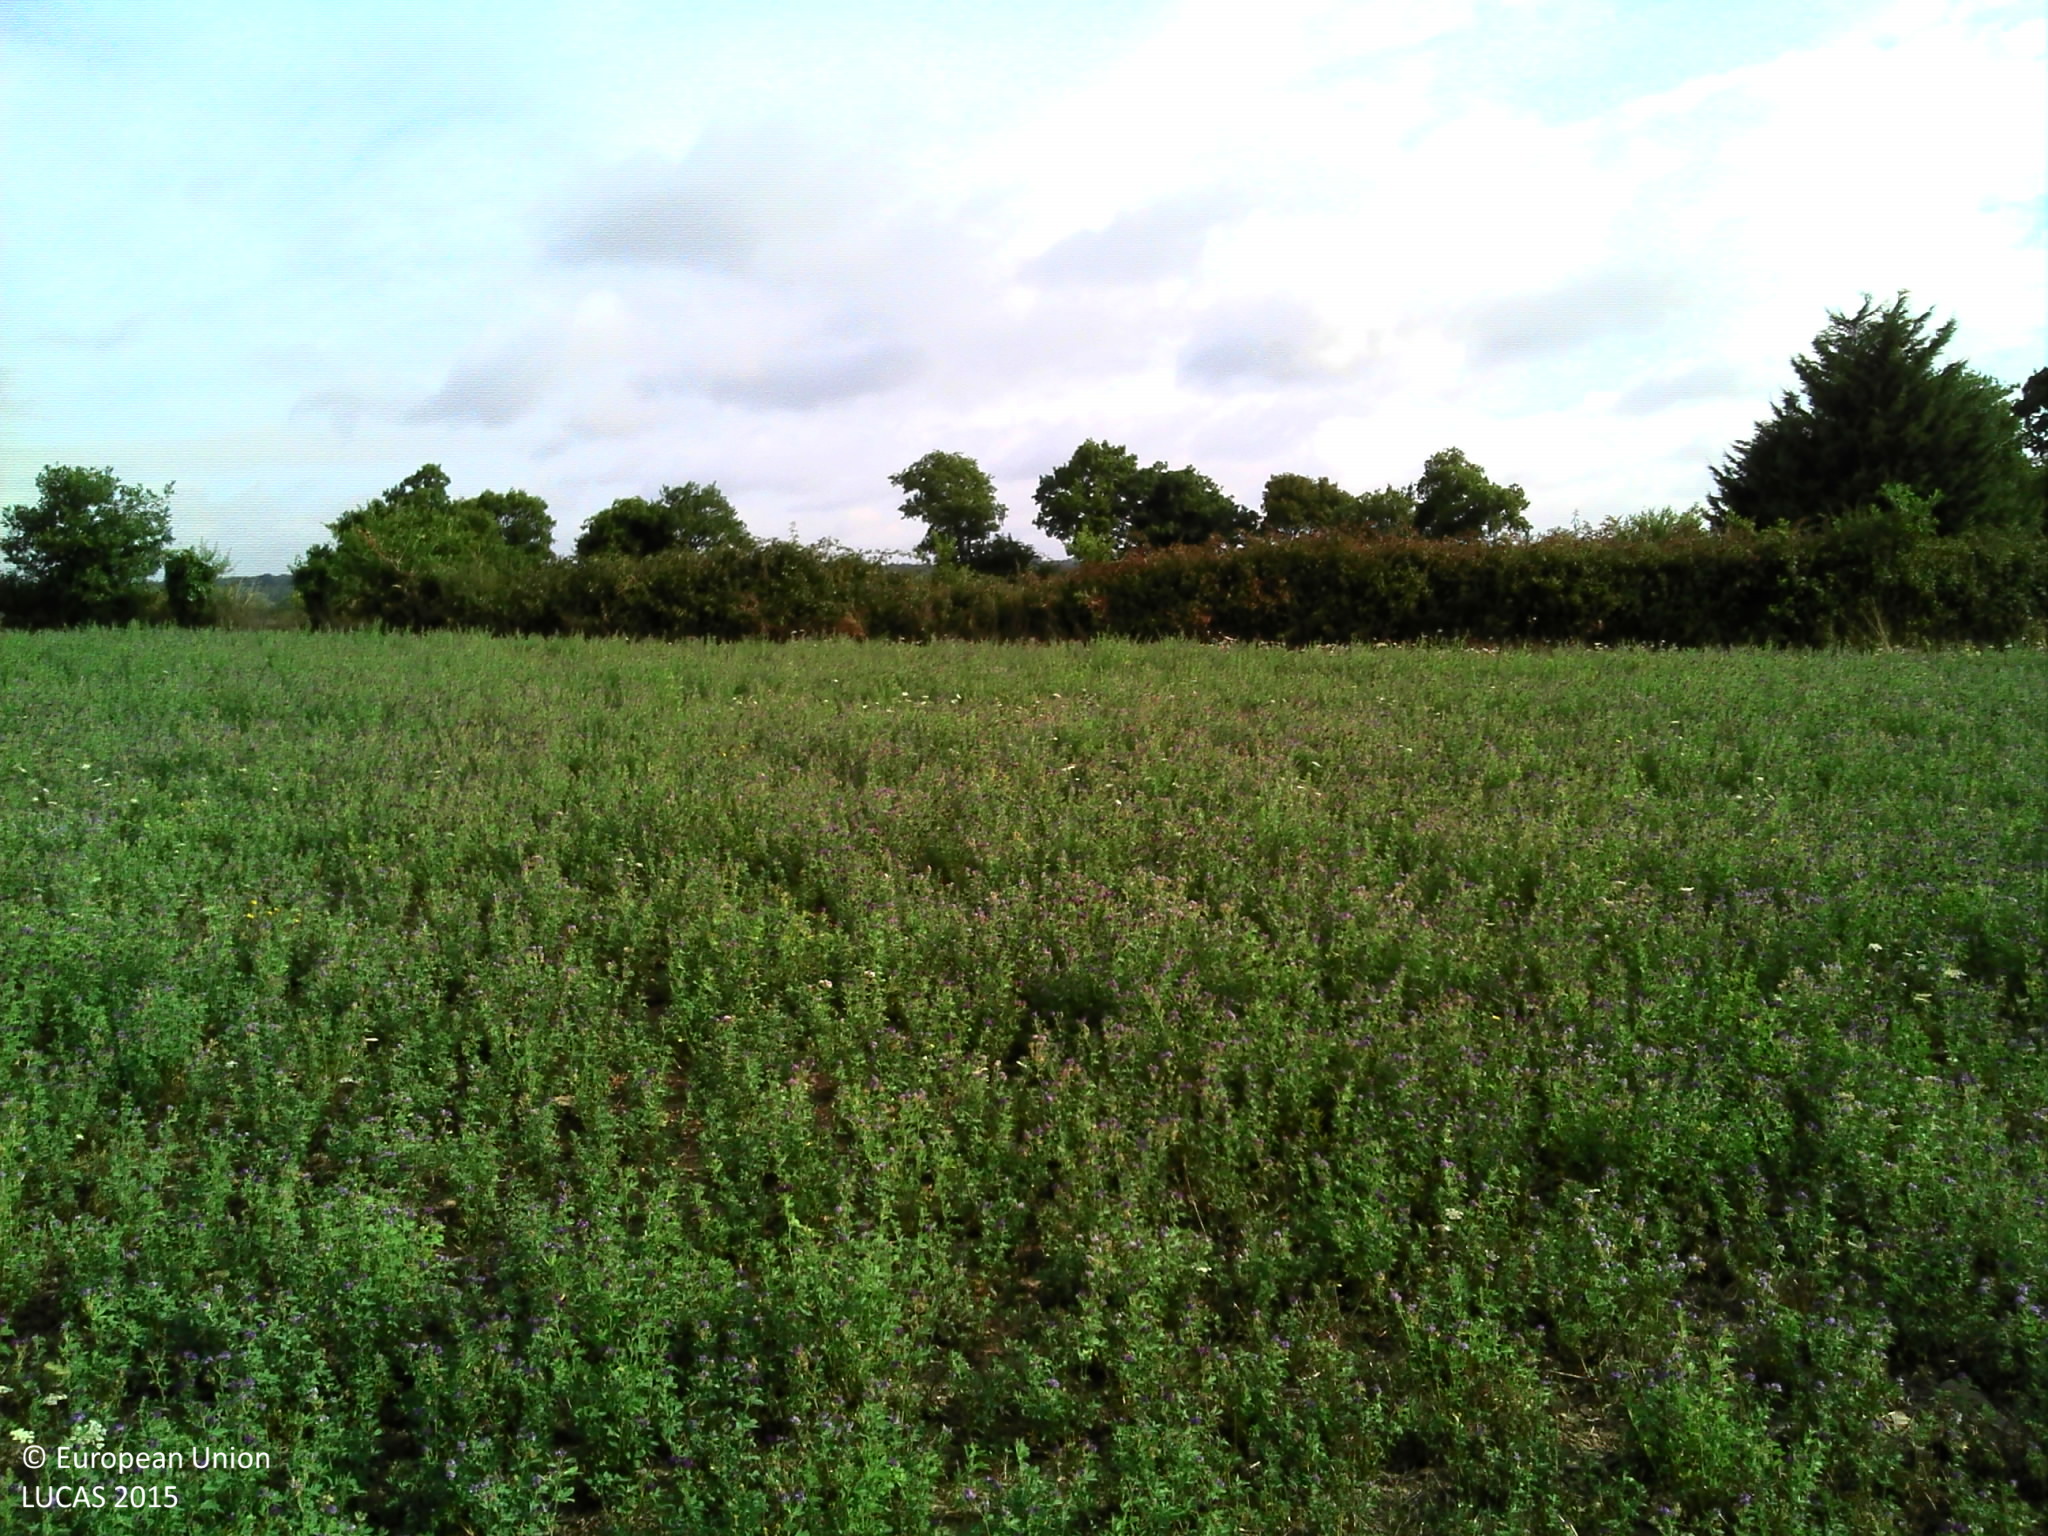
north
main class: Cropland
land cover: Lucerne
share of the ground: > 75 %
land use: Agriculture (excluding fallow land and kitchen gardens)
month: August
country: FR
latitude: 47.7755
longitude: -1.3994
